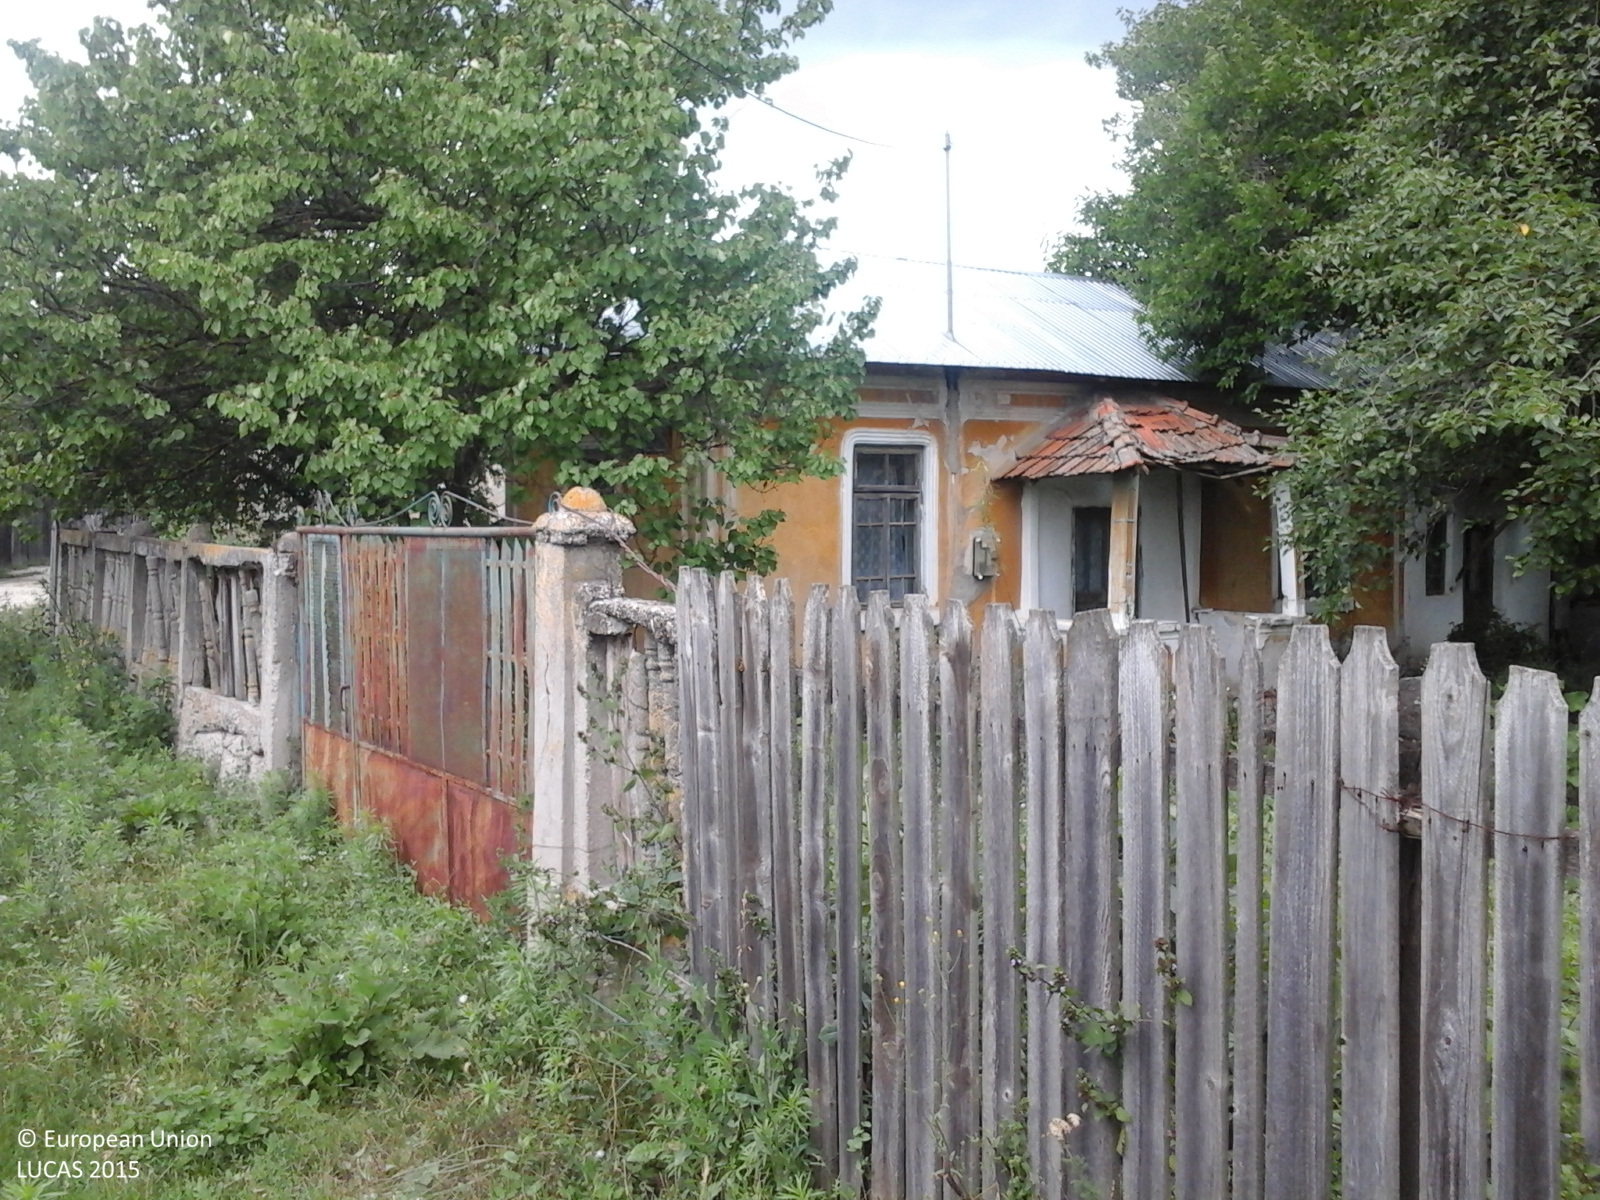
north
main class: Cropland
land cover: Pear fruit
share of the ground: 50 - 75 %
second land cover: Spontaneously vegetated surfaces
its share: > 75 %
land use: Agriculture (excluding fallow land and kitchen gardens)
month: July
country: RO
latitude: 44.0355
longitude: 24.6570
